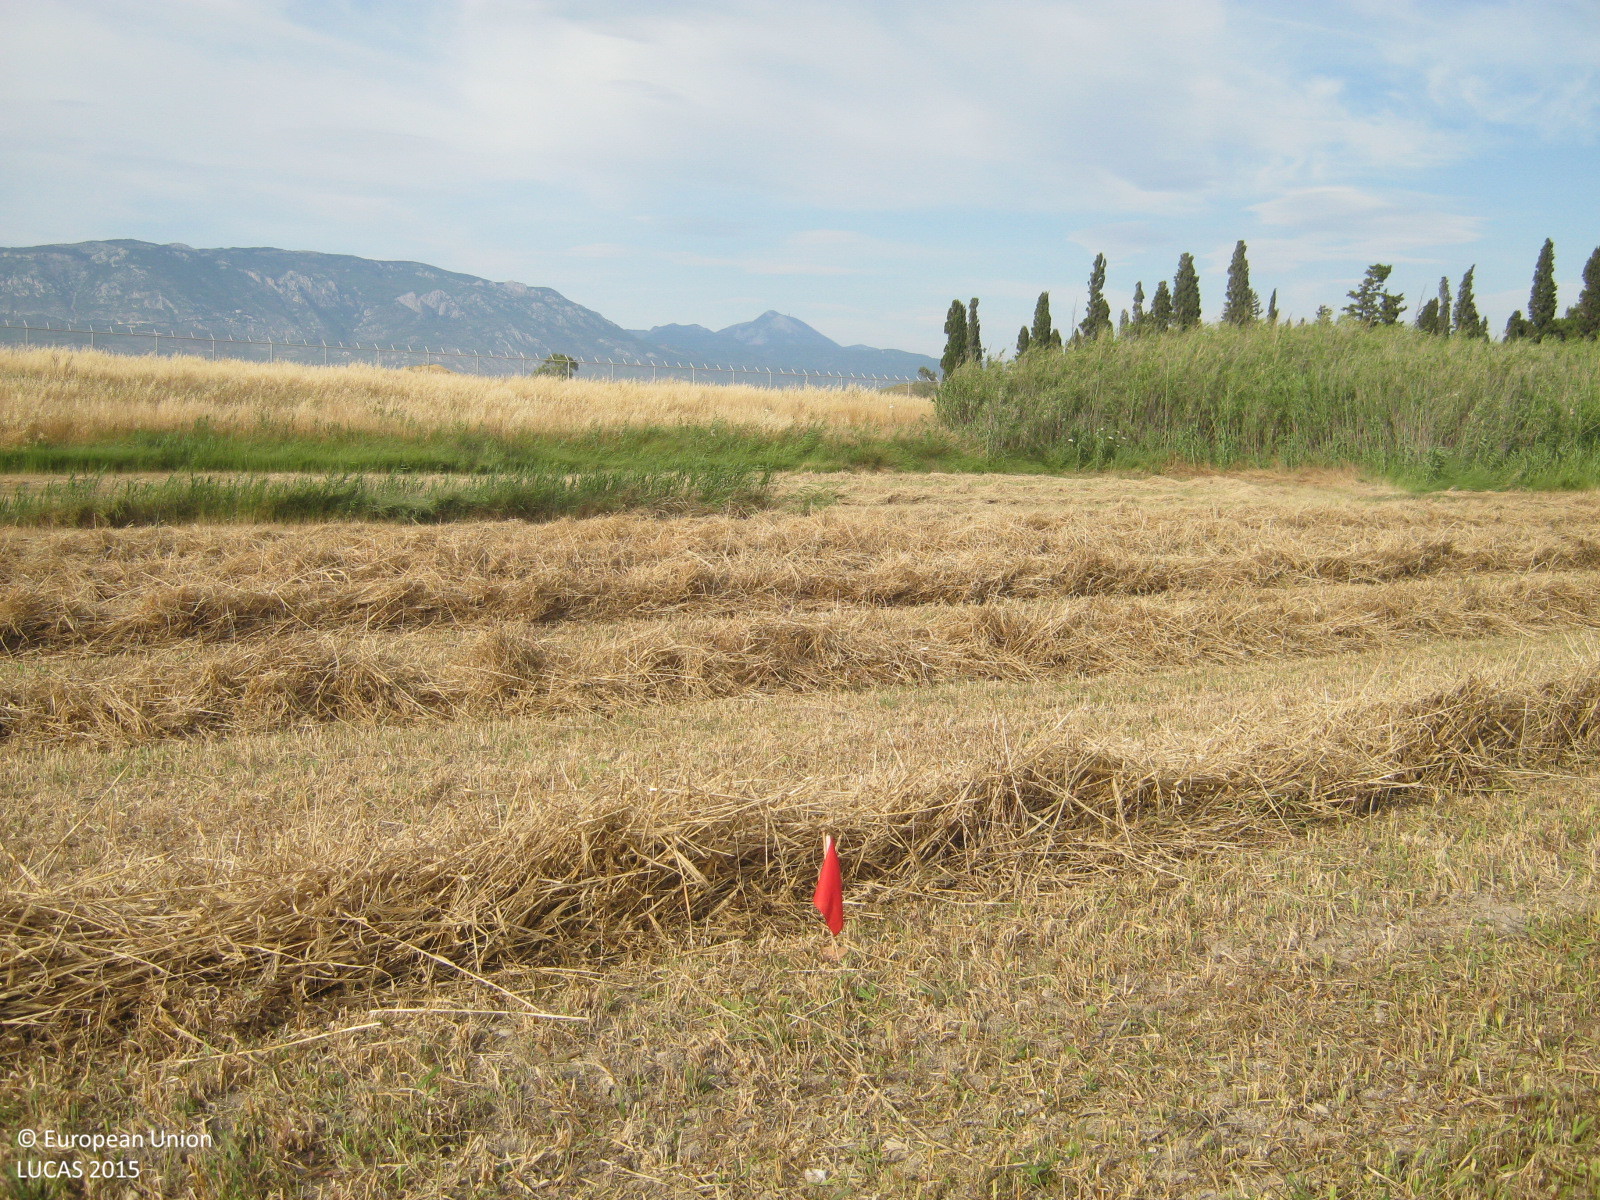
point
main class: Cropland
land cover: Barley
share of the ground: < 10 %
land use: Agriculture (excluding fallow land and kitchen gardens)
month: June
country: GR
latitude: 37.9305
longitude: 22.8848
